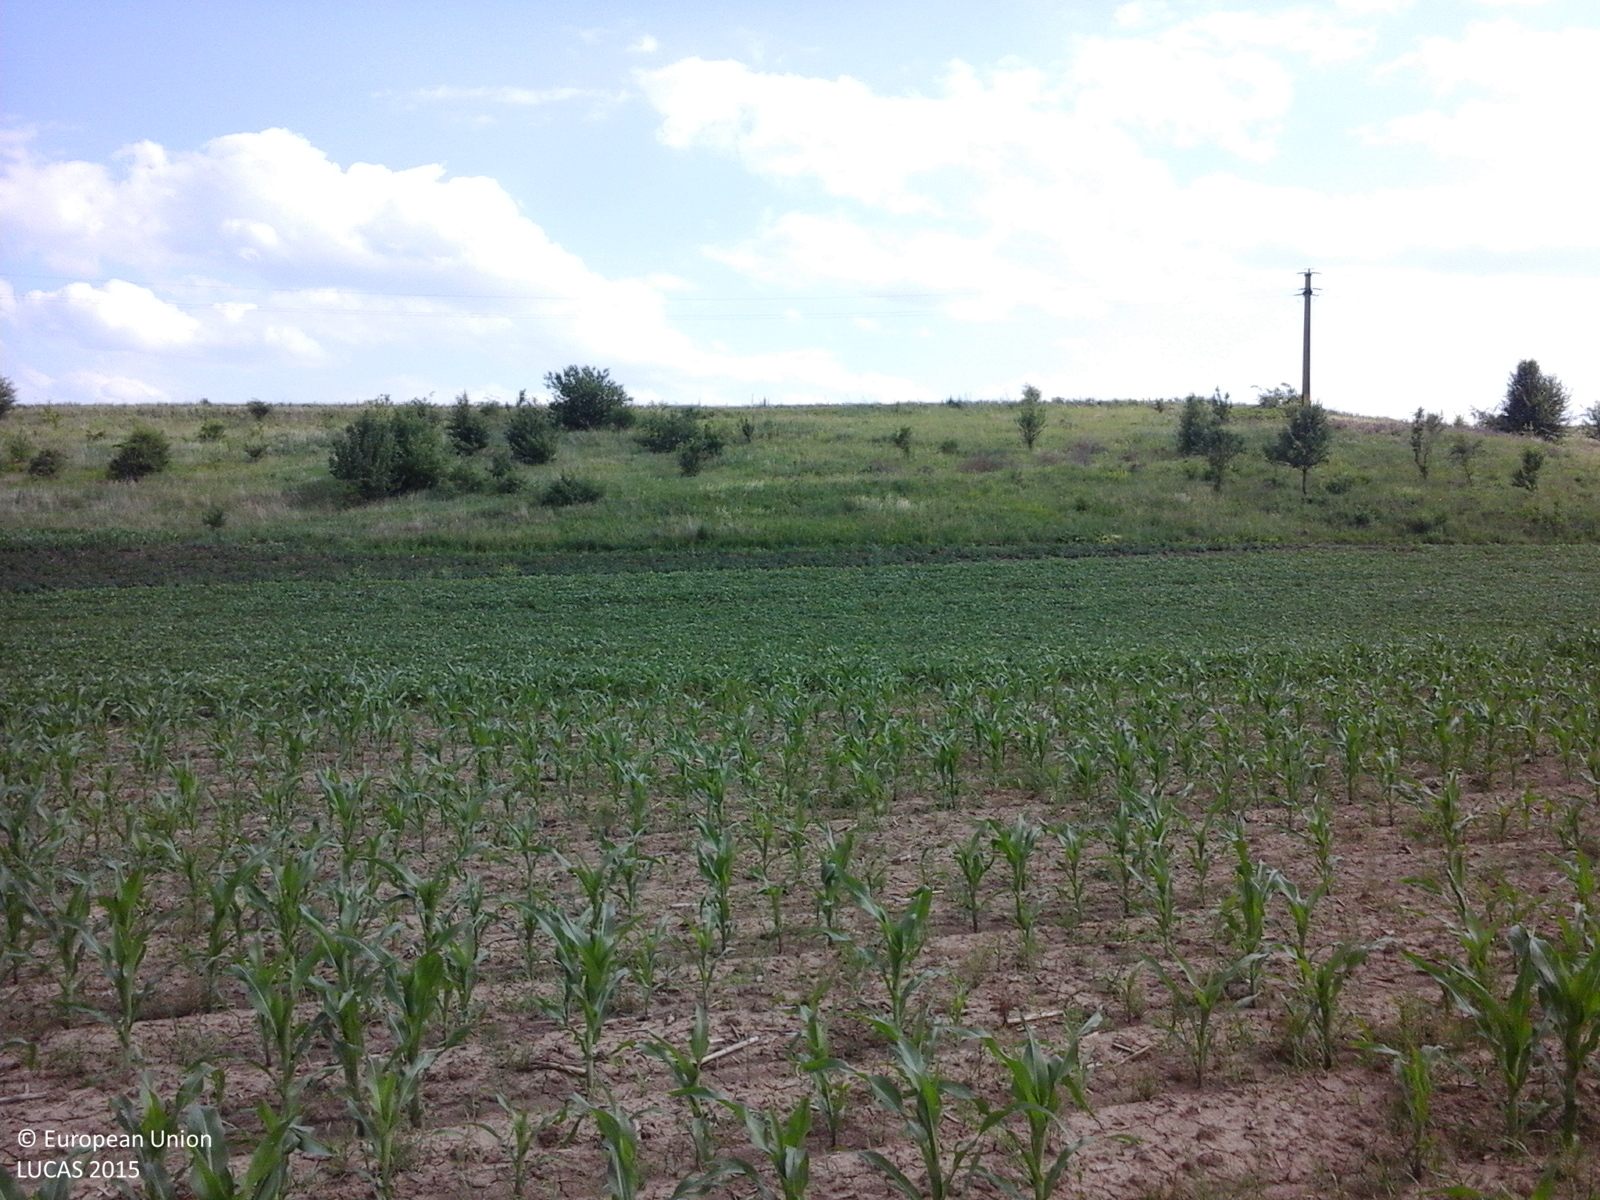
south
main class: Cropland
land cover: Lucerne
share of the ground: > 75 %
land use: Agriculture (excluding fallow land and kitchen gardens)
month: June
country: RO
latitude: 47.7160
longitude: 26.4170
